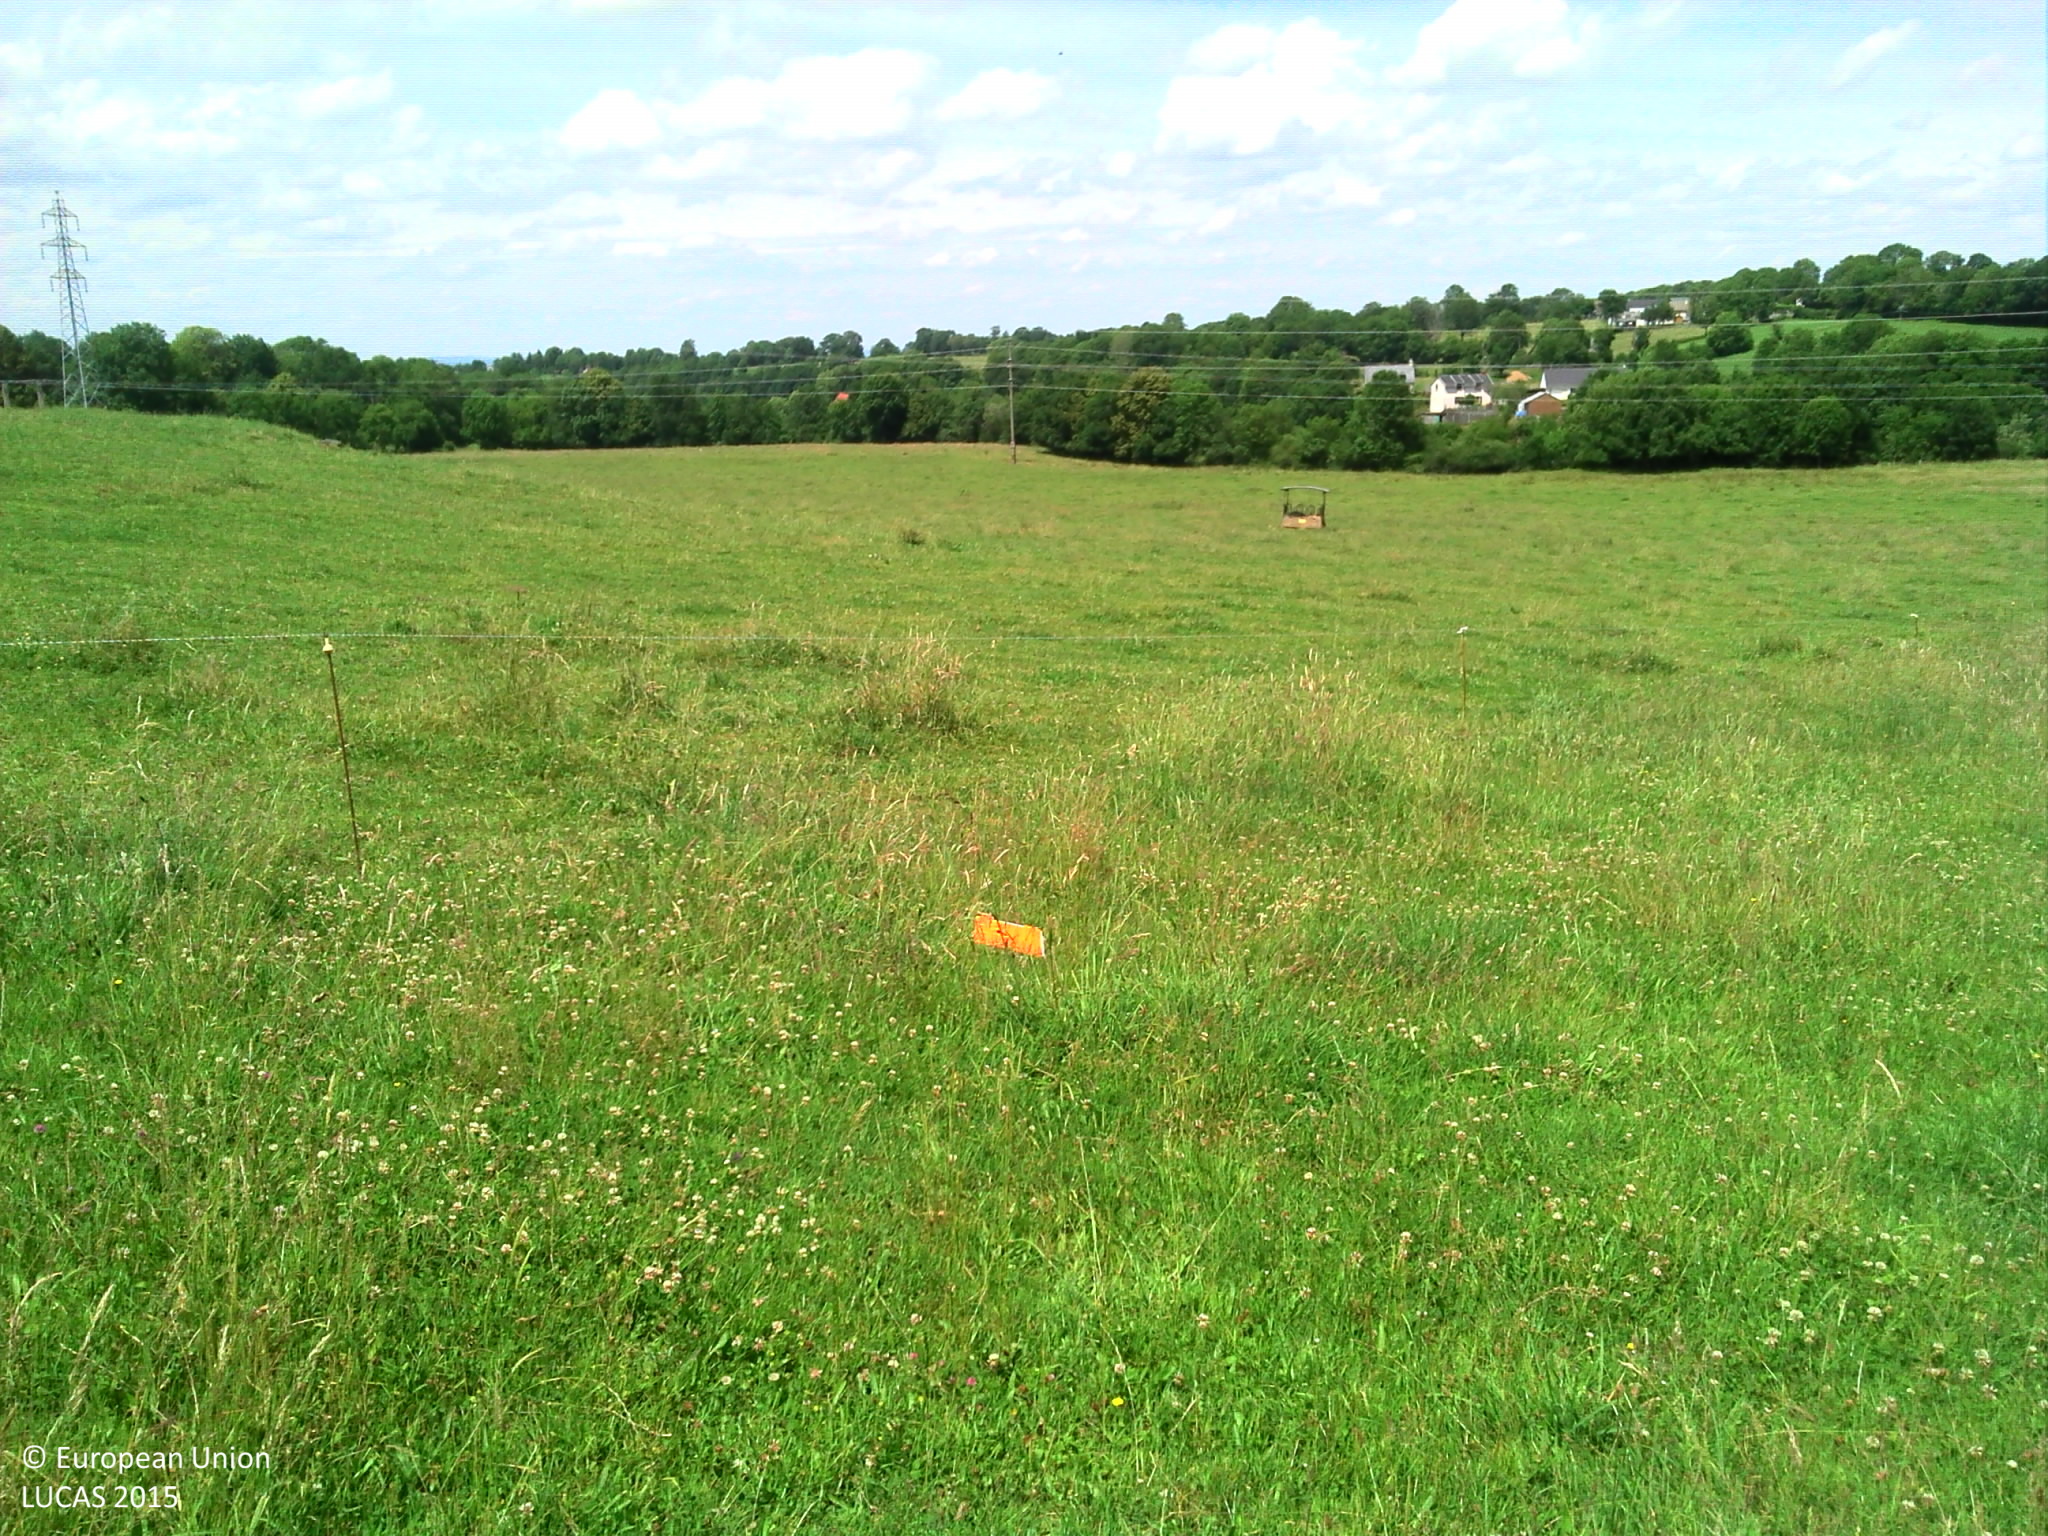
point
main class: Grassland
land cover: Grassland without tree/shrub cover
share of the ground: > 75 %
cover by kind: herbaceous plants 100 %
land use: Agriculture (excluding fallow land and kitchen gardens)
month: June
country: FR
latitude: 45.2262
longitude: 2.3445
